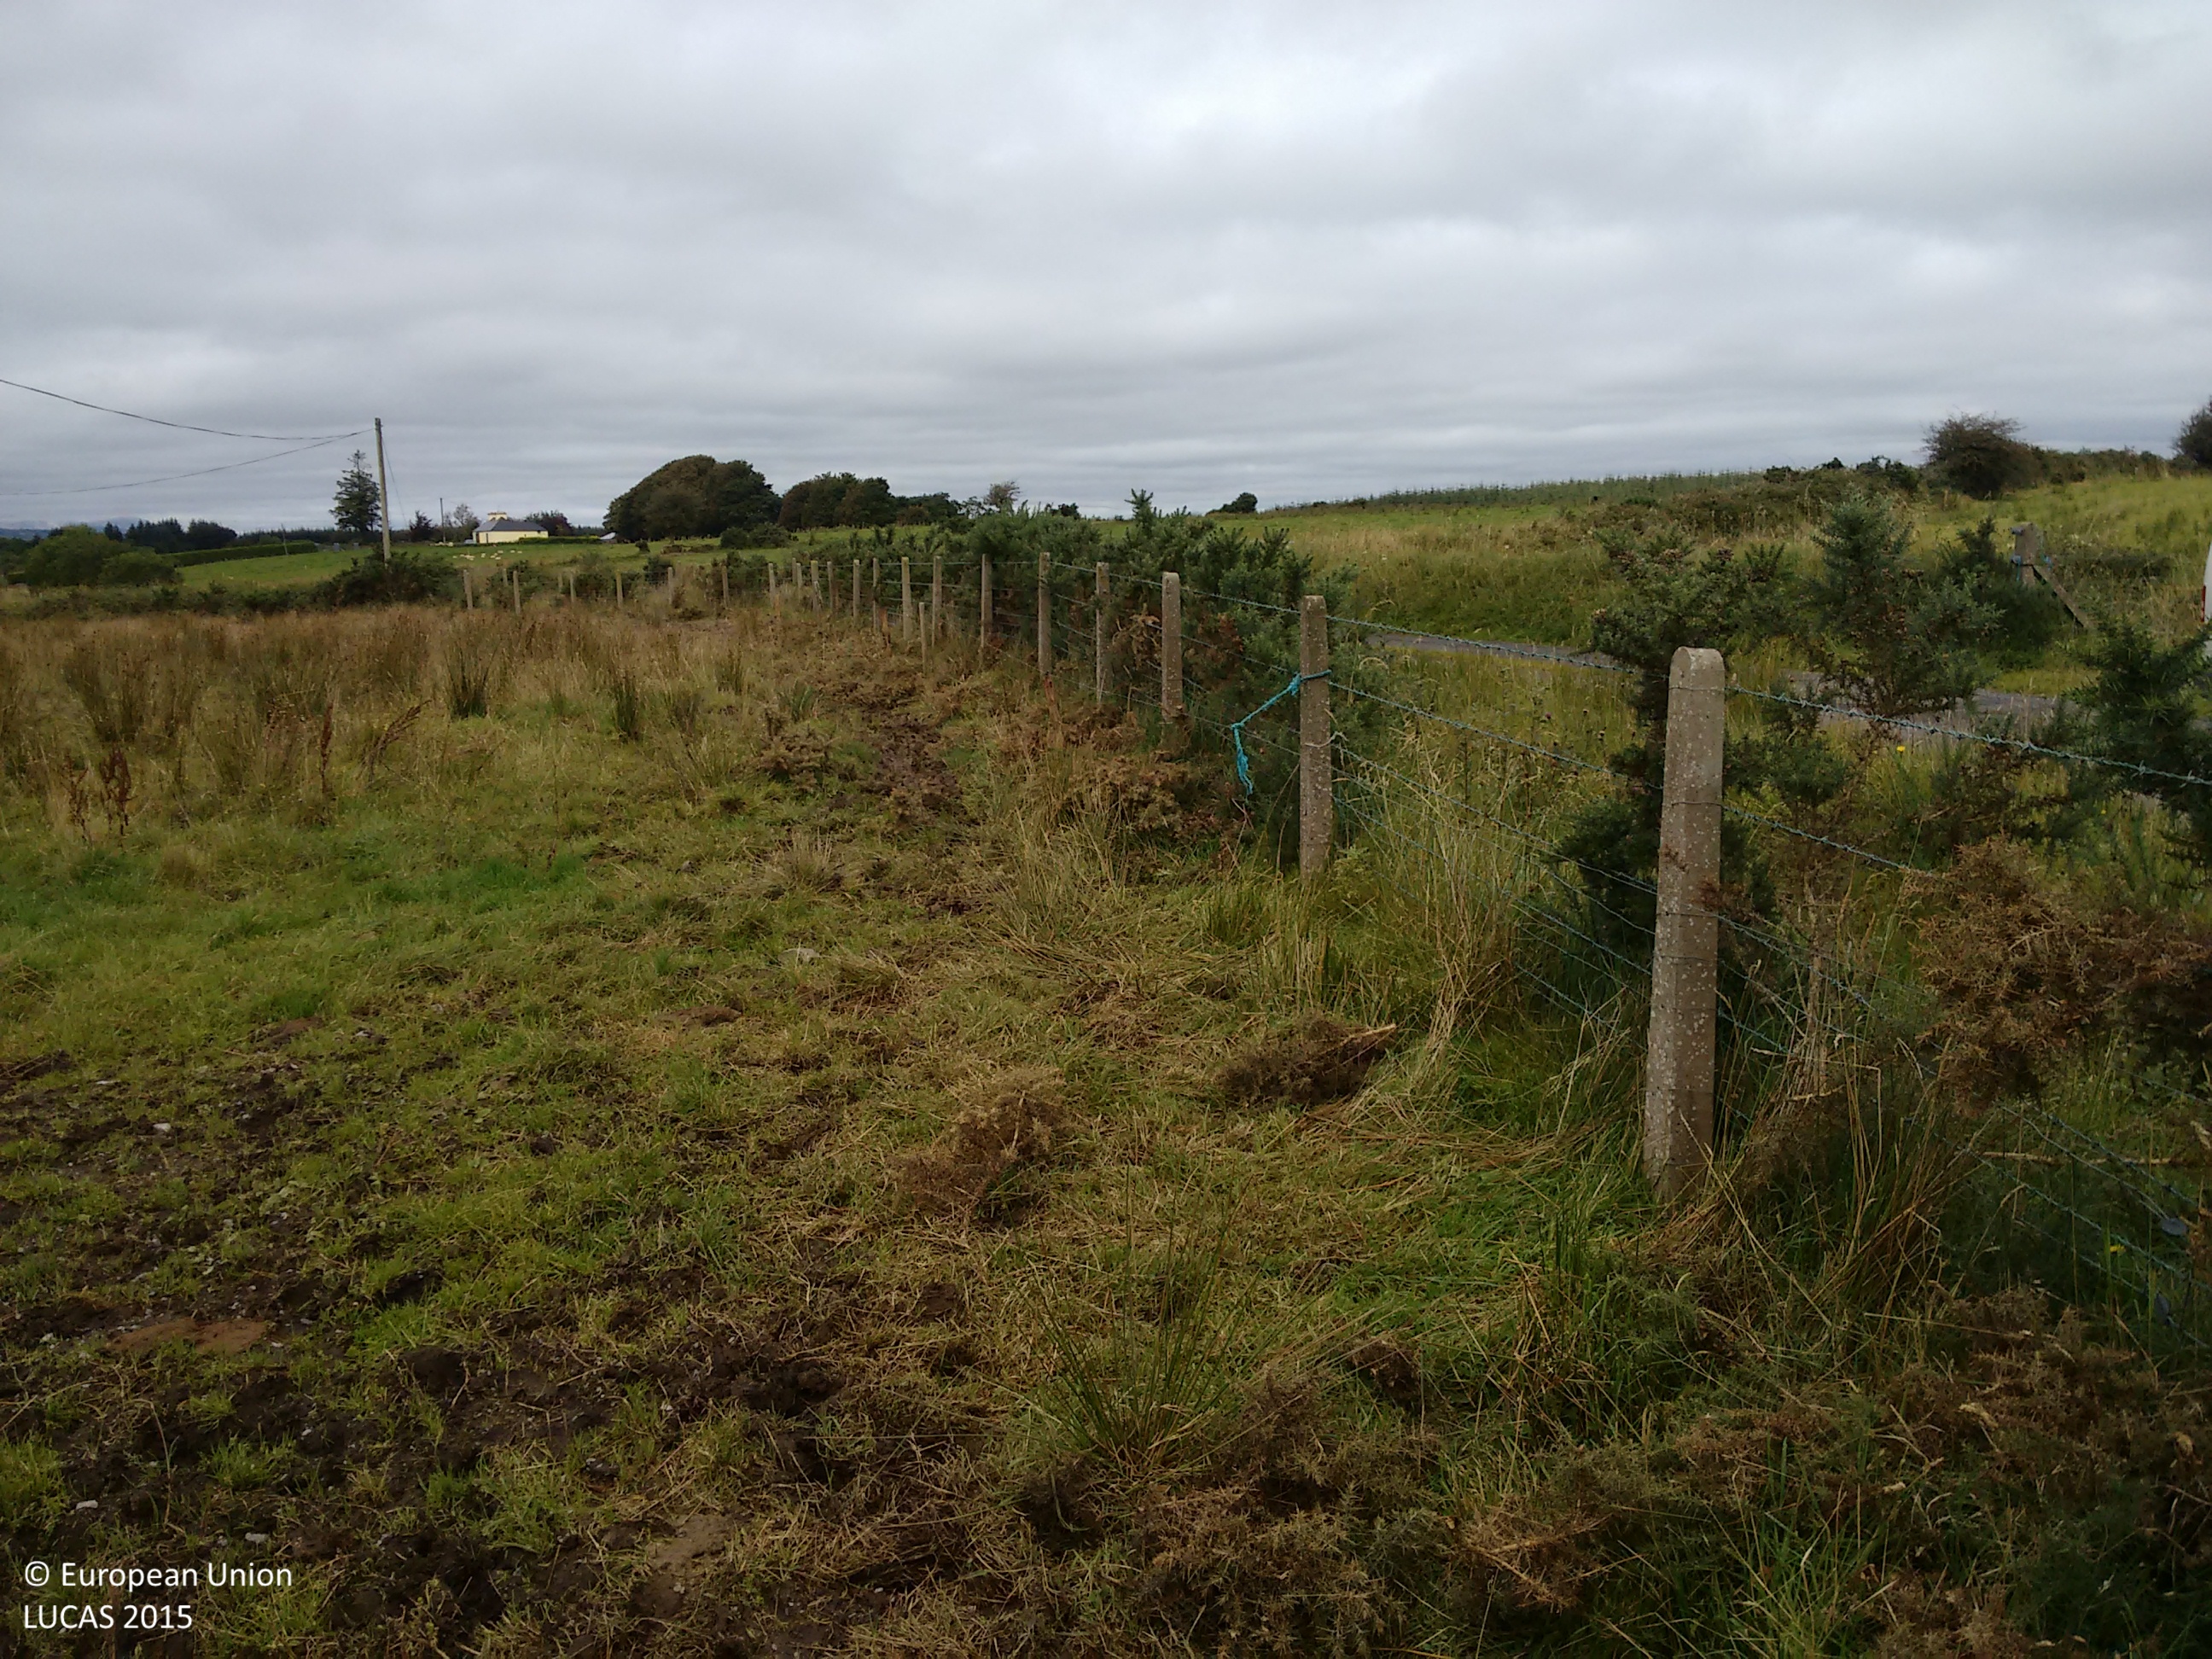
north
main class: Grassland
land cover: Grassland without tree/shrub cover
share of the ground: > 75 %
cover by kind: herbaceous plants 100 %
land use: Agriculture (excluding fallow land and kitchen gardens)
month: September
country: IE
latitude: 53.8120
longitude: -8.9353
